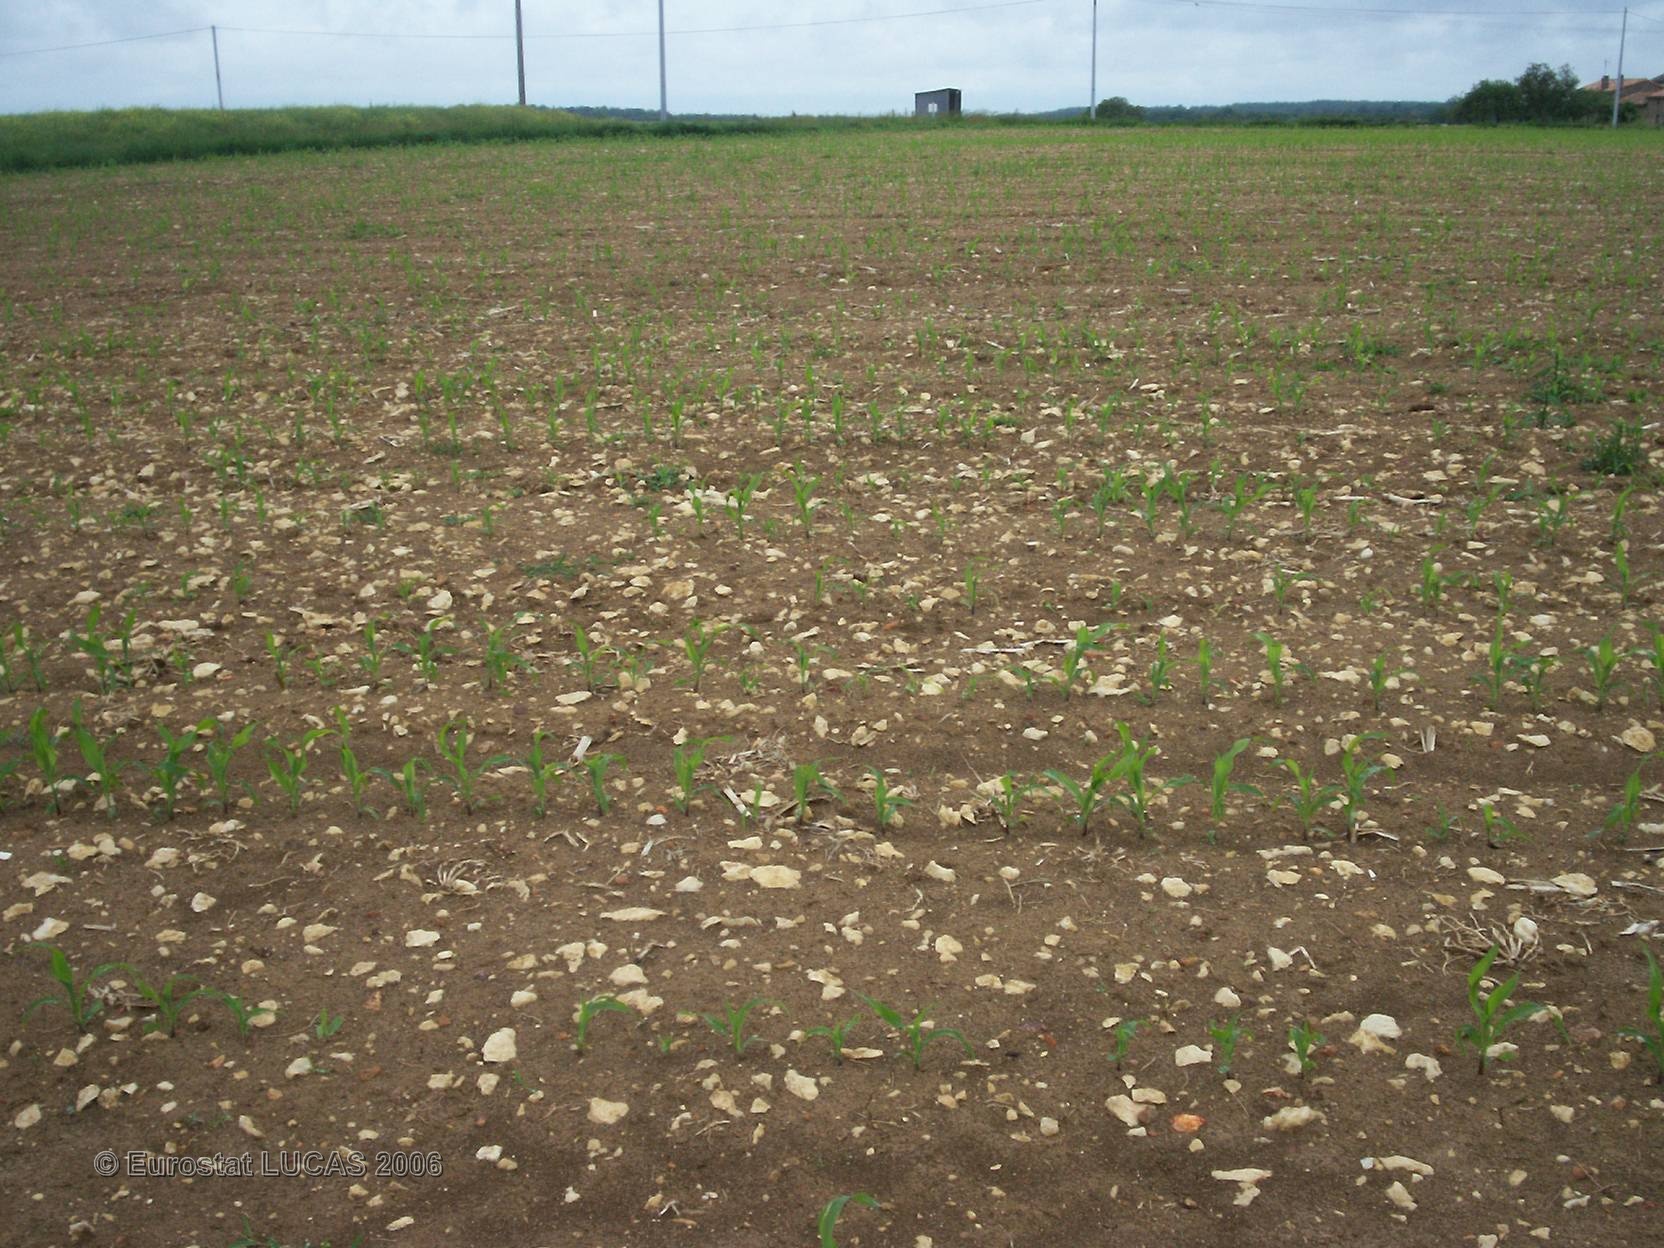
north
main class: Cropland
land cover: Maize
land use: Agriculture (excluding fallow land and kitchen gardens)
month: May
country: FR
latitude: 46.6666
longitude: 0.4533
